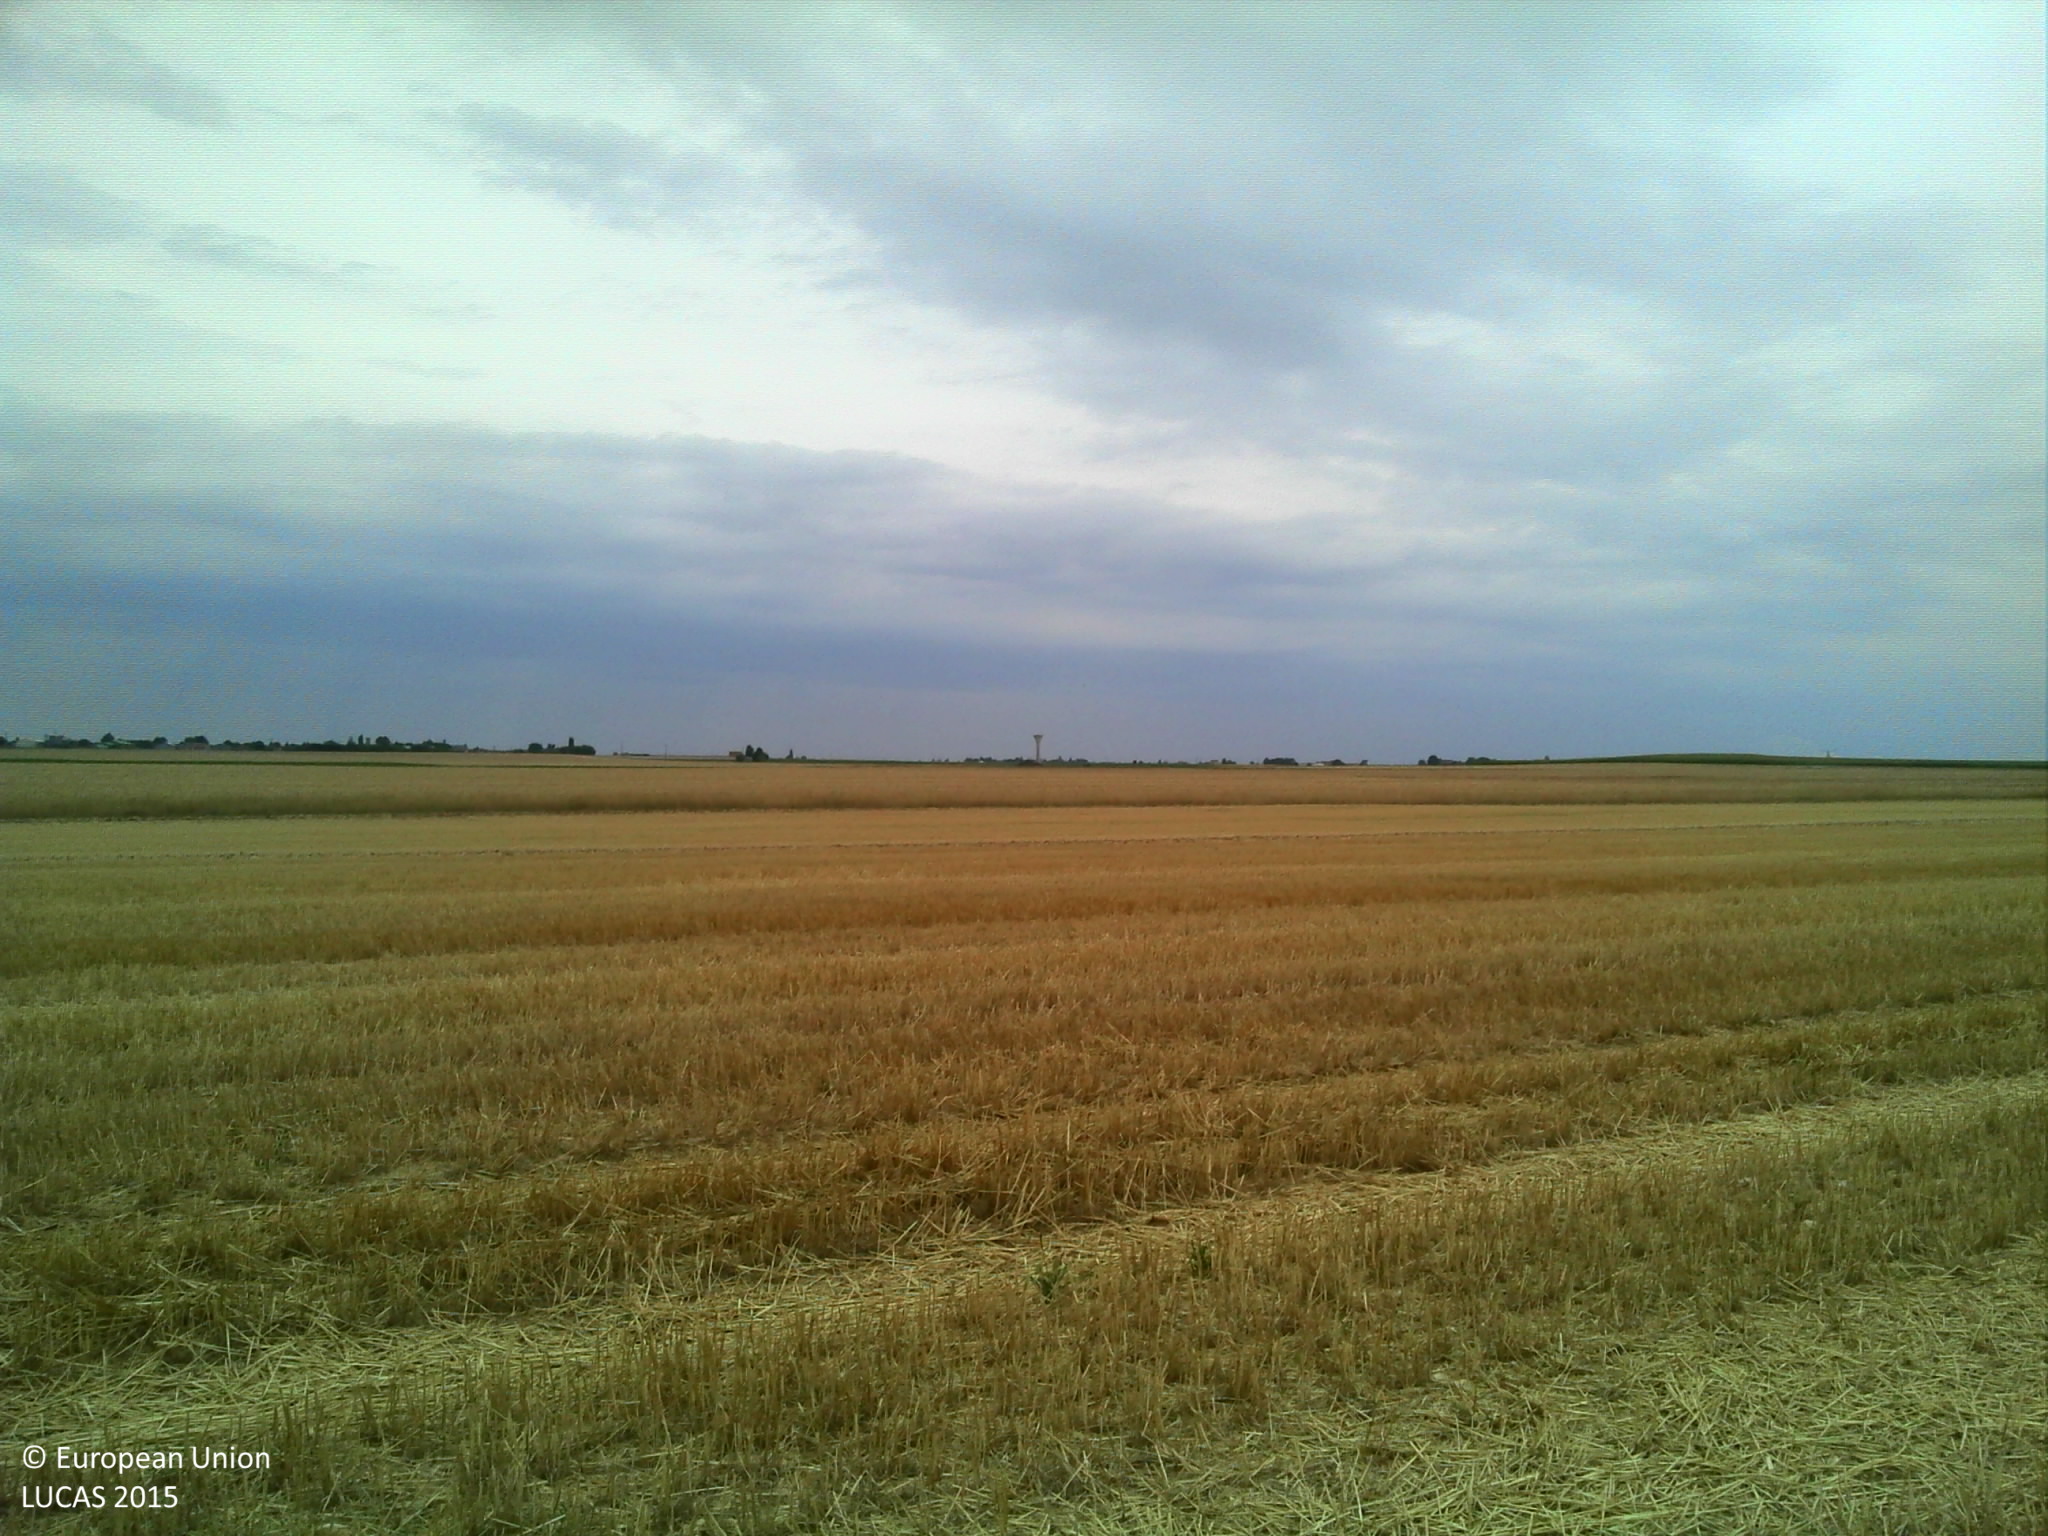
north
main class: Cropland
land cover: Common wheat
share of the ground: > 75 %
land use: Agriculture (excluding fallow land and kitchen gardens)
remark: Harvested field
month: August
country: FR
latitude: 48.1685
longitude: 2.5275
